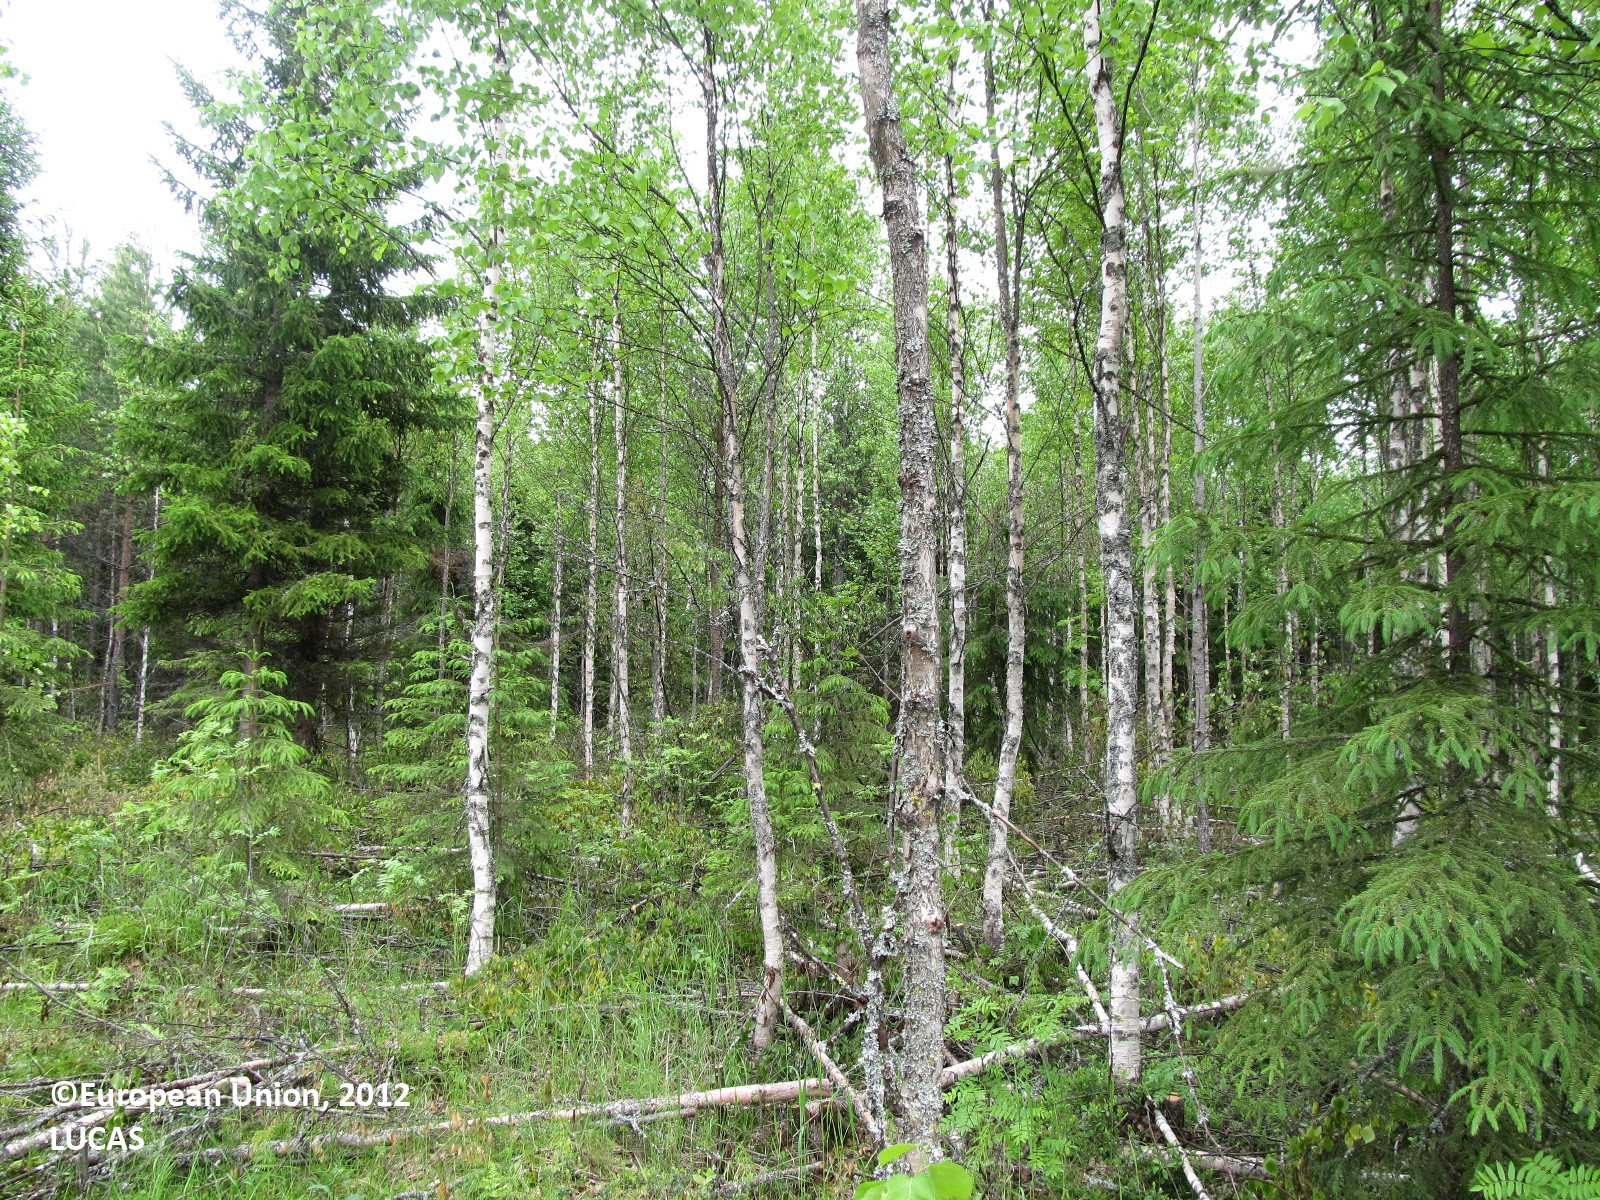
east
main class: Woodland
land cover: Spruce dominated mixed woodland
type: boreal forest
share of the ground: 10 - 25 %
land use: Forestry
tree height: < 5 m
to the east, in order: Spruce dominated mixed woodland; Ditches and canals; Pine dominated coniferous woodland; Ditches and canals; Pine dominated coniferous woodland; Ditches and canals; Pine dominated mixed woodland; Spruce dominated mixed woodland
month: June
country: FI
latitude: 63.1878
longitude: 27.8360
